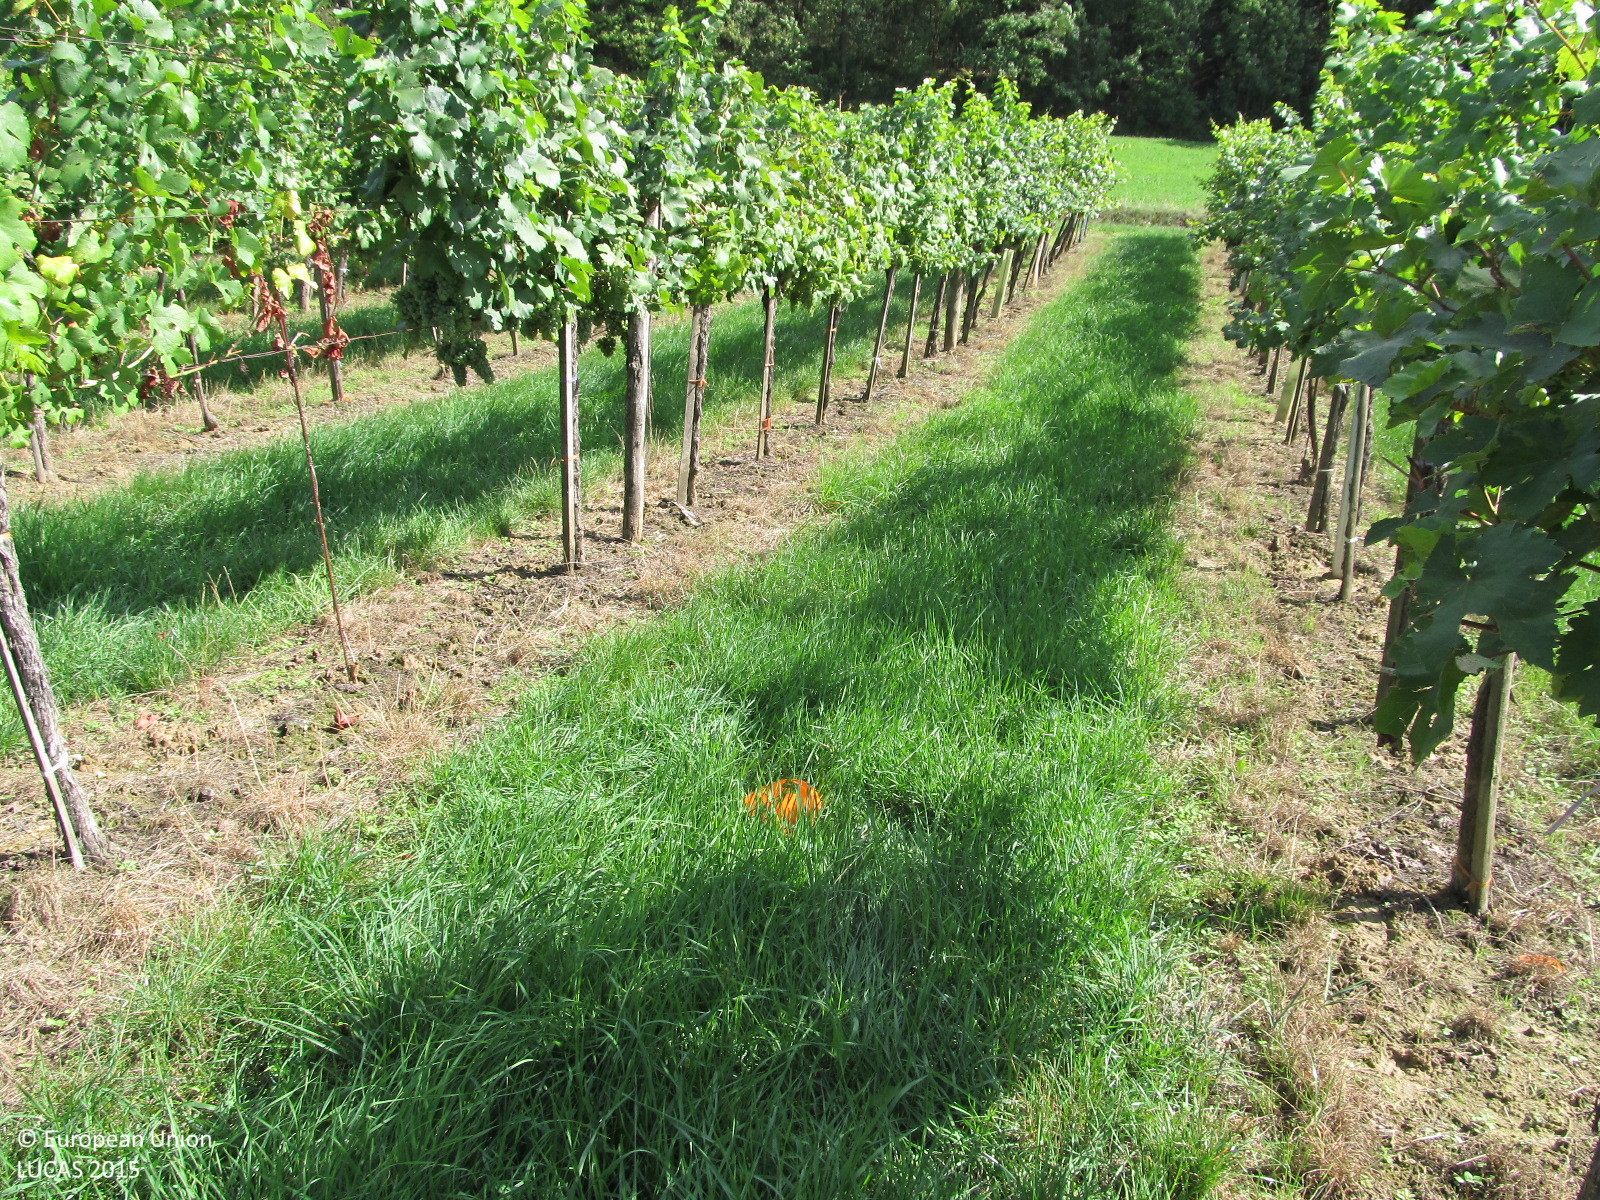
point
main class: Cropland
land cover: Vineyards
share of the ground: 25 - 50 %
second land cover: Grassland without tree/shrub cover
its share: 50 - 75 %
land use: Agriculture (excluding fallow land and kitchen gardens)
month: September
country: AT
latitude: 48.5004
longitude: 15.8640
